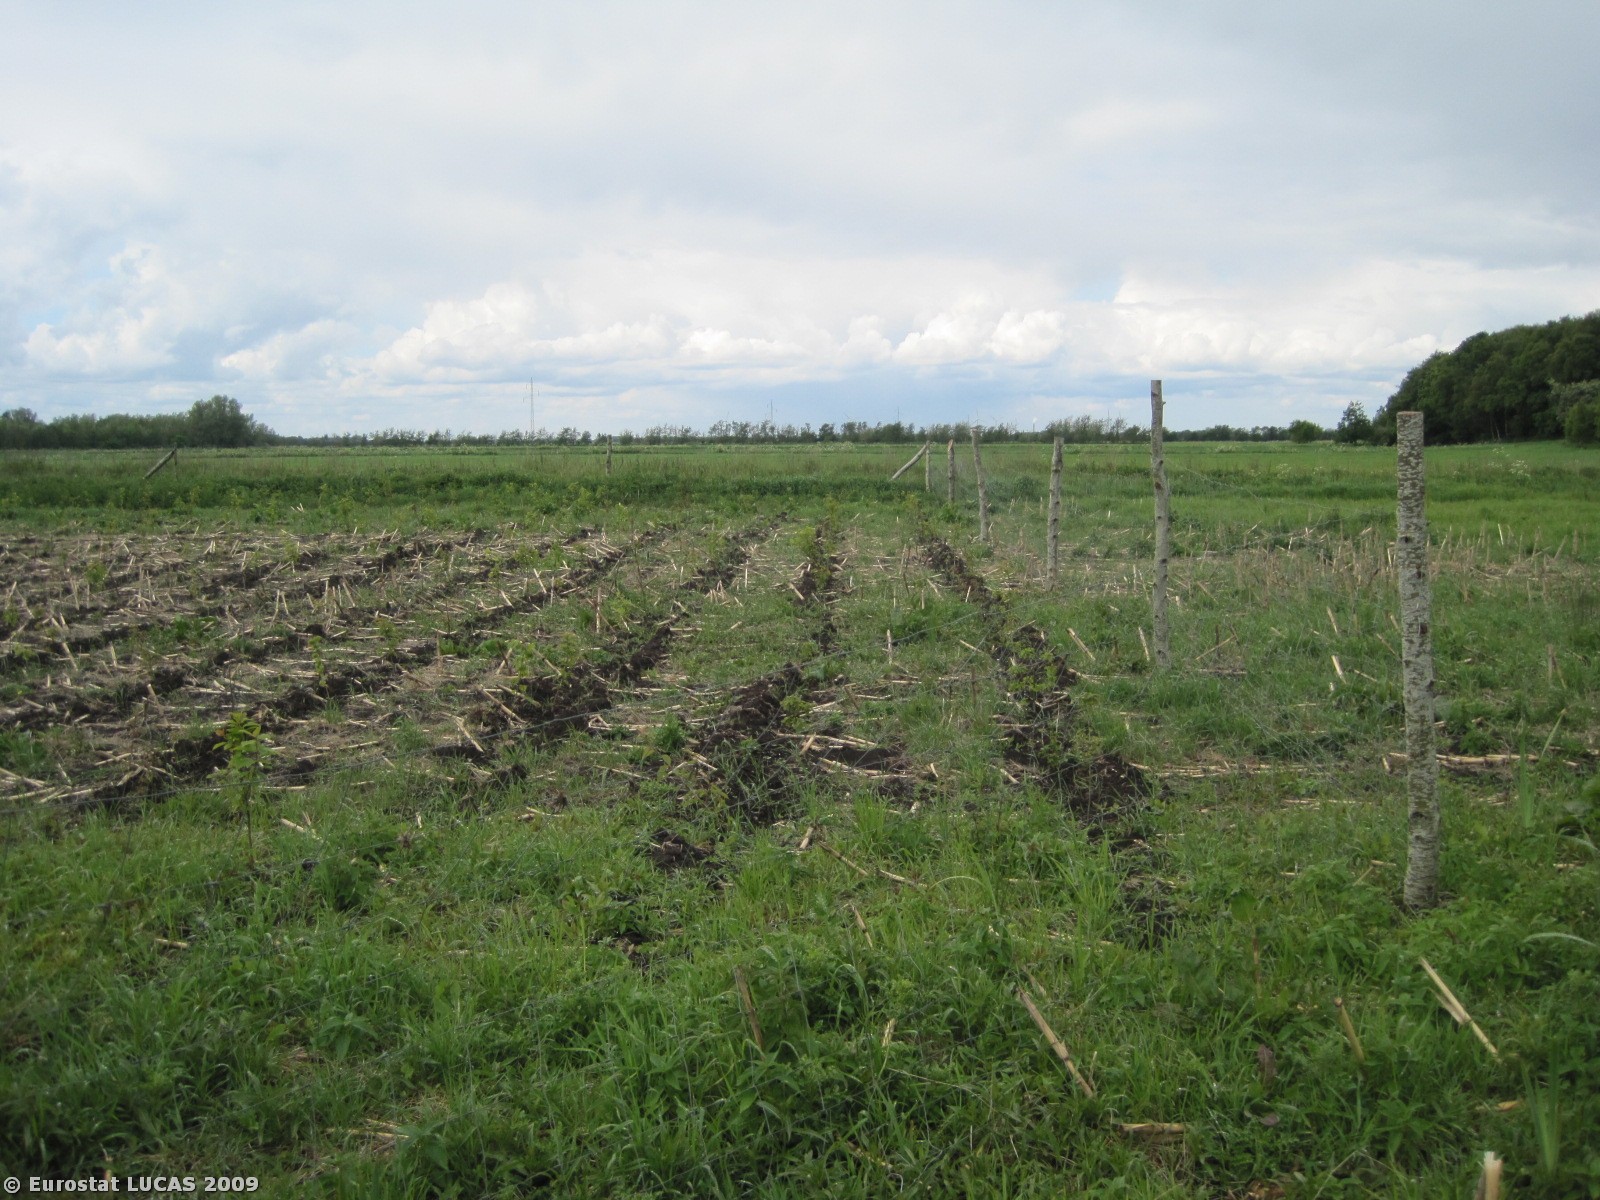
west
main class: Grassland
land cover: Grassland without tree/shrub cover
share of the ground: > 75 %
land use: Agriculture (excluding fallow land and kitchen gardens)
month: June
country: DK
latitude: 57.0503
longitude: 10.2798
